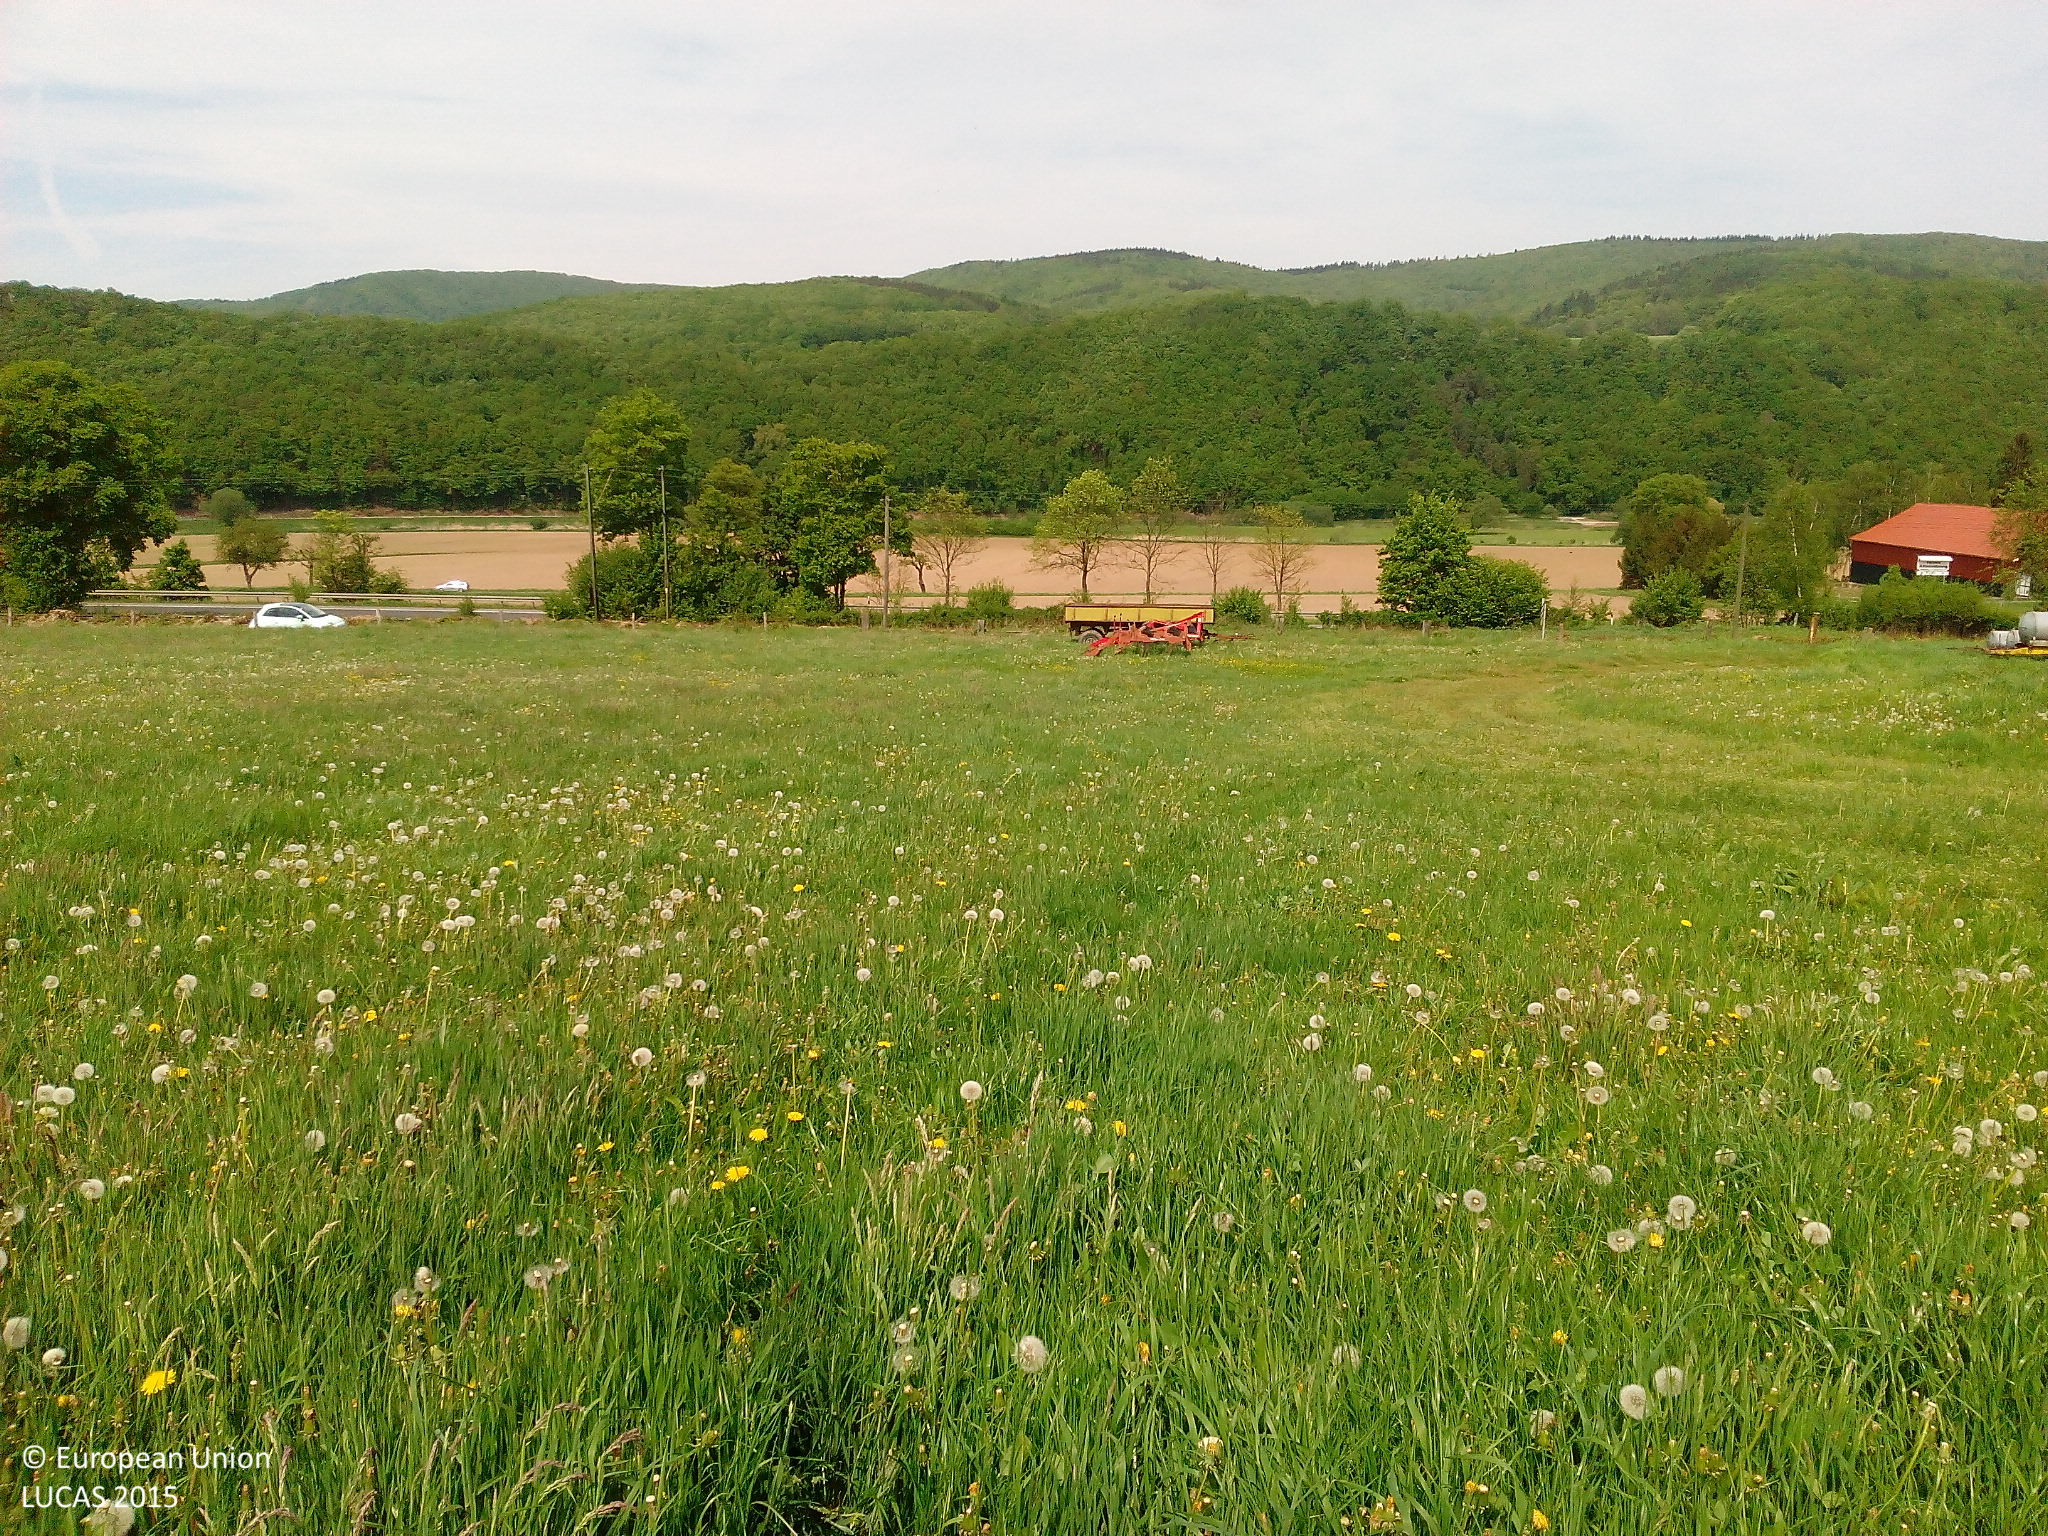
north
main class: Grassland
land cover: Grassland without tree/shrub cover
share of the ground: > 75 %
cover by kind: herbaceous plants 100 %
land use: Agriculture (excluding fallow land and kitchen gardens)
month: May
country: DE
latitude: 51.2989
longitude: 9.9570
